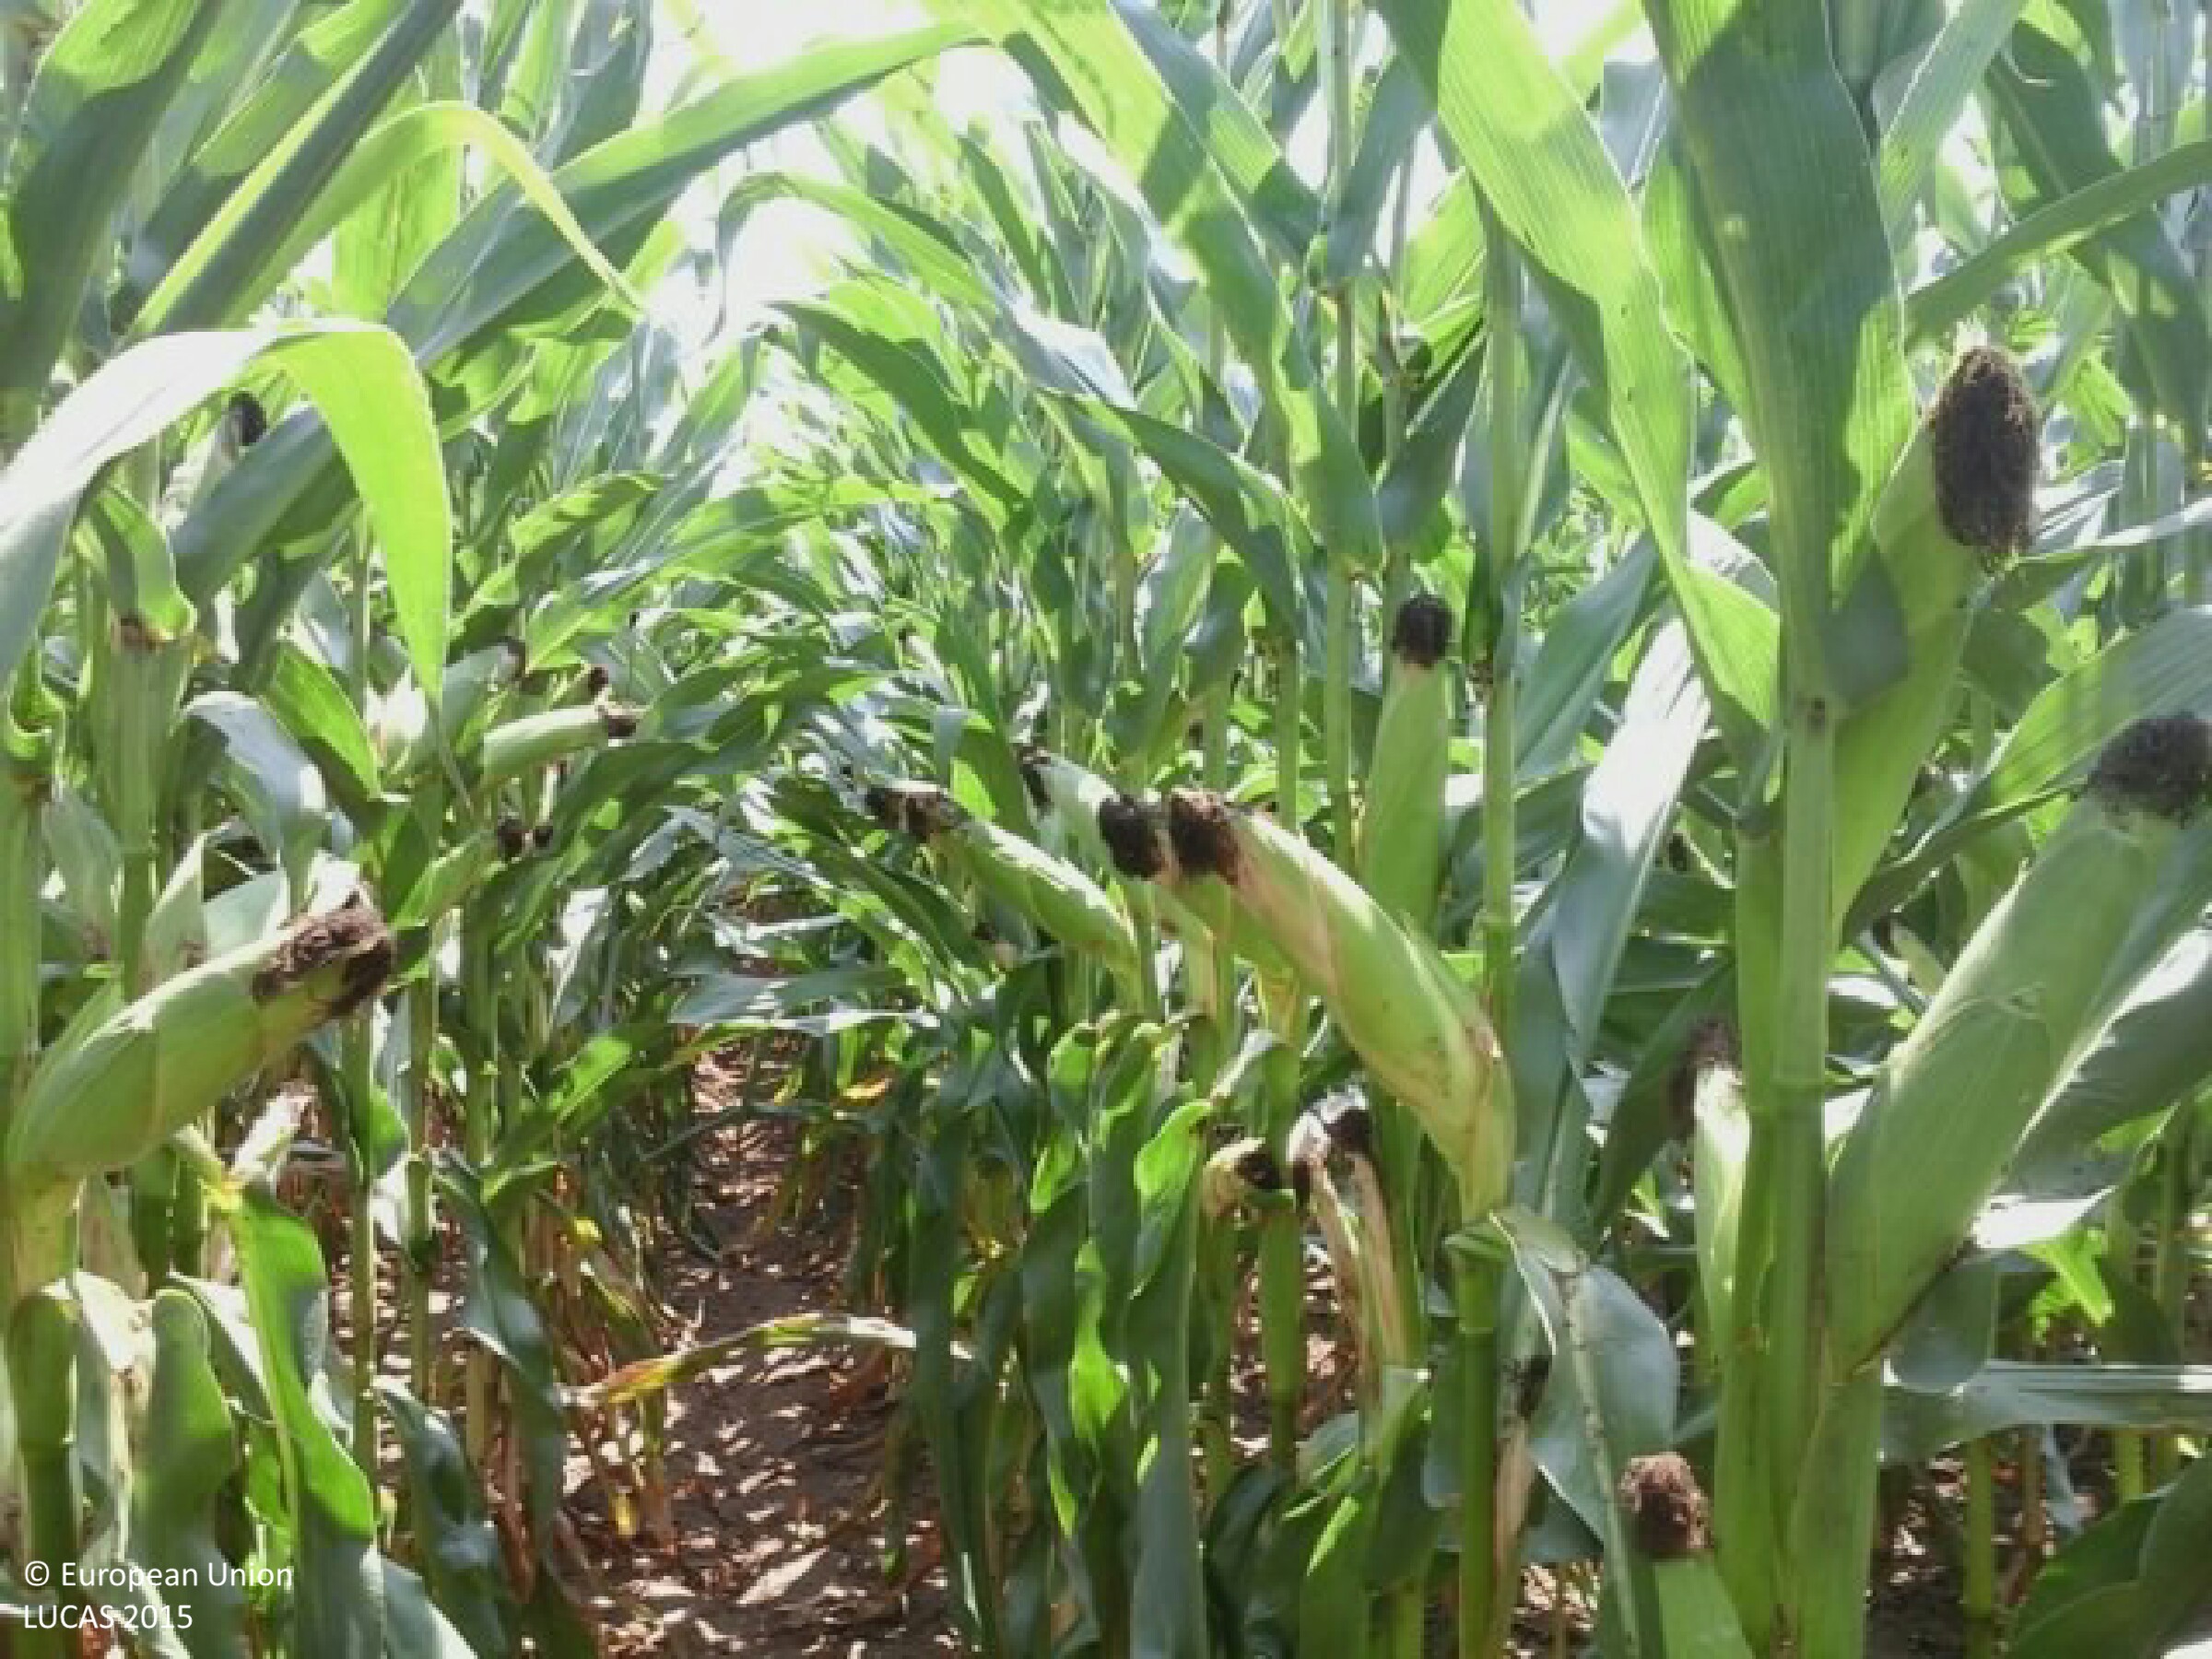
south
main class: Cropland
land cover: Maize
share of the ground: > 75 %
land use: Agriculture (excluding fallow land and kitchen gardens)
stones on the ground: < 10 %
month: August
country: HU
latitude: 46.4956
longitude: 17.8633
